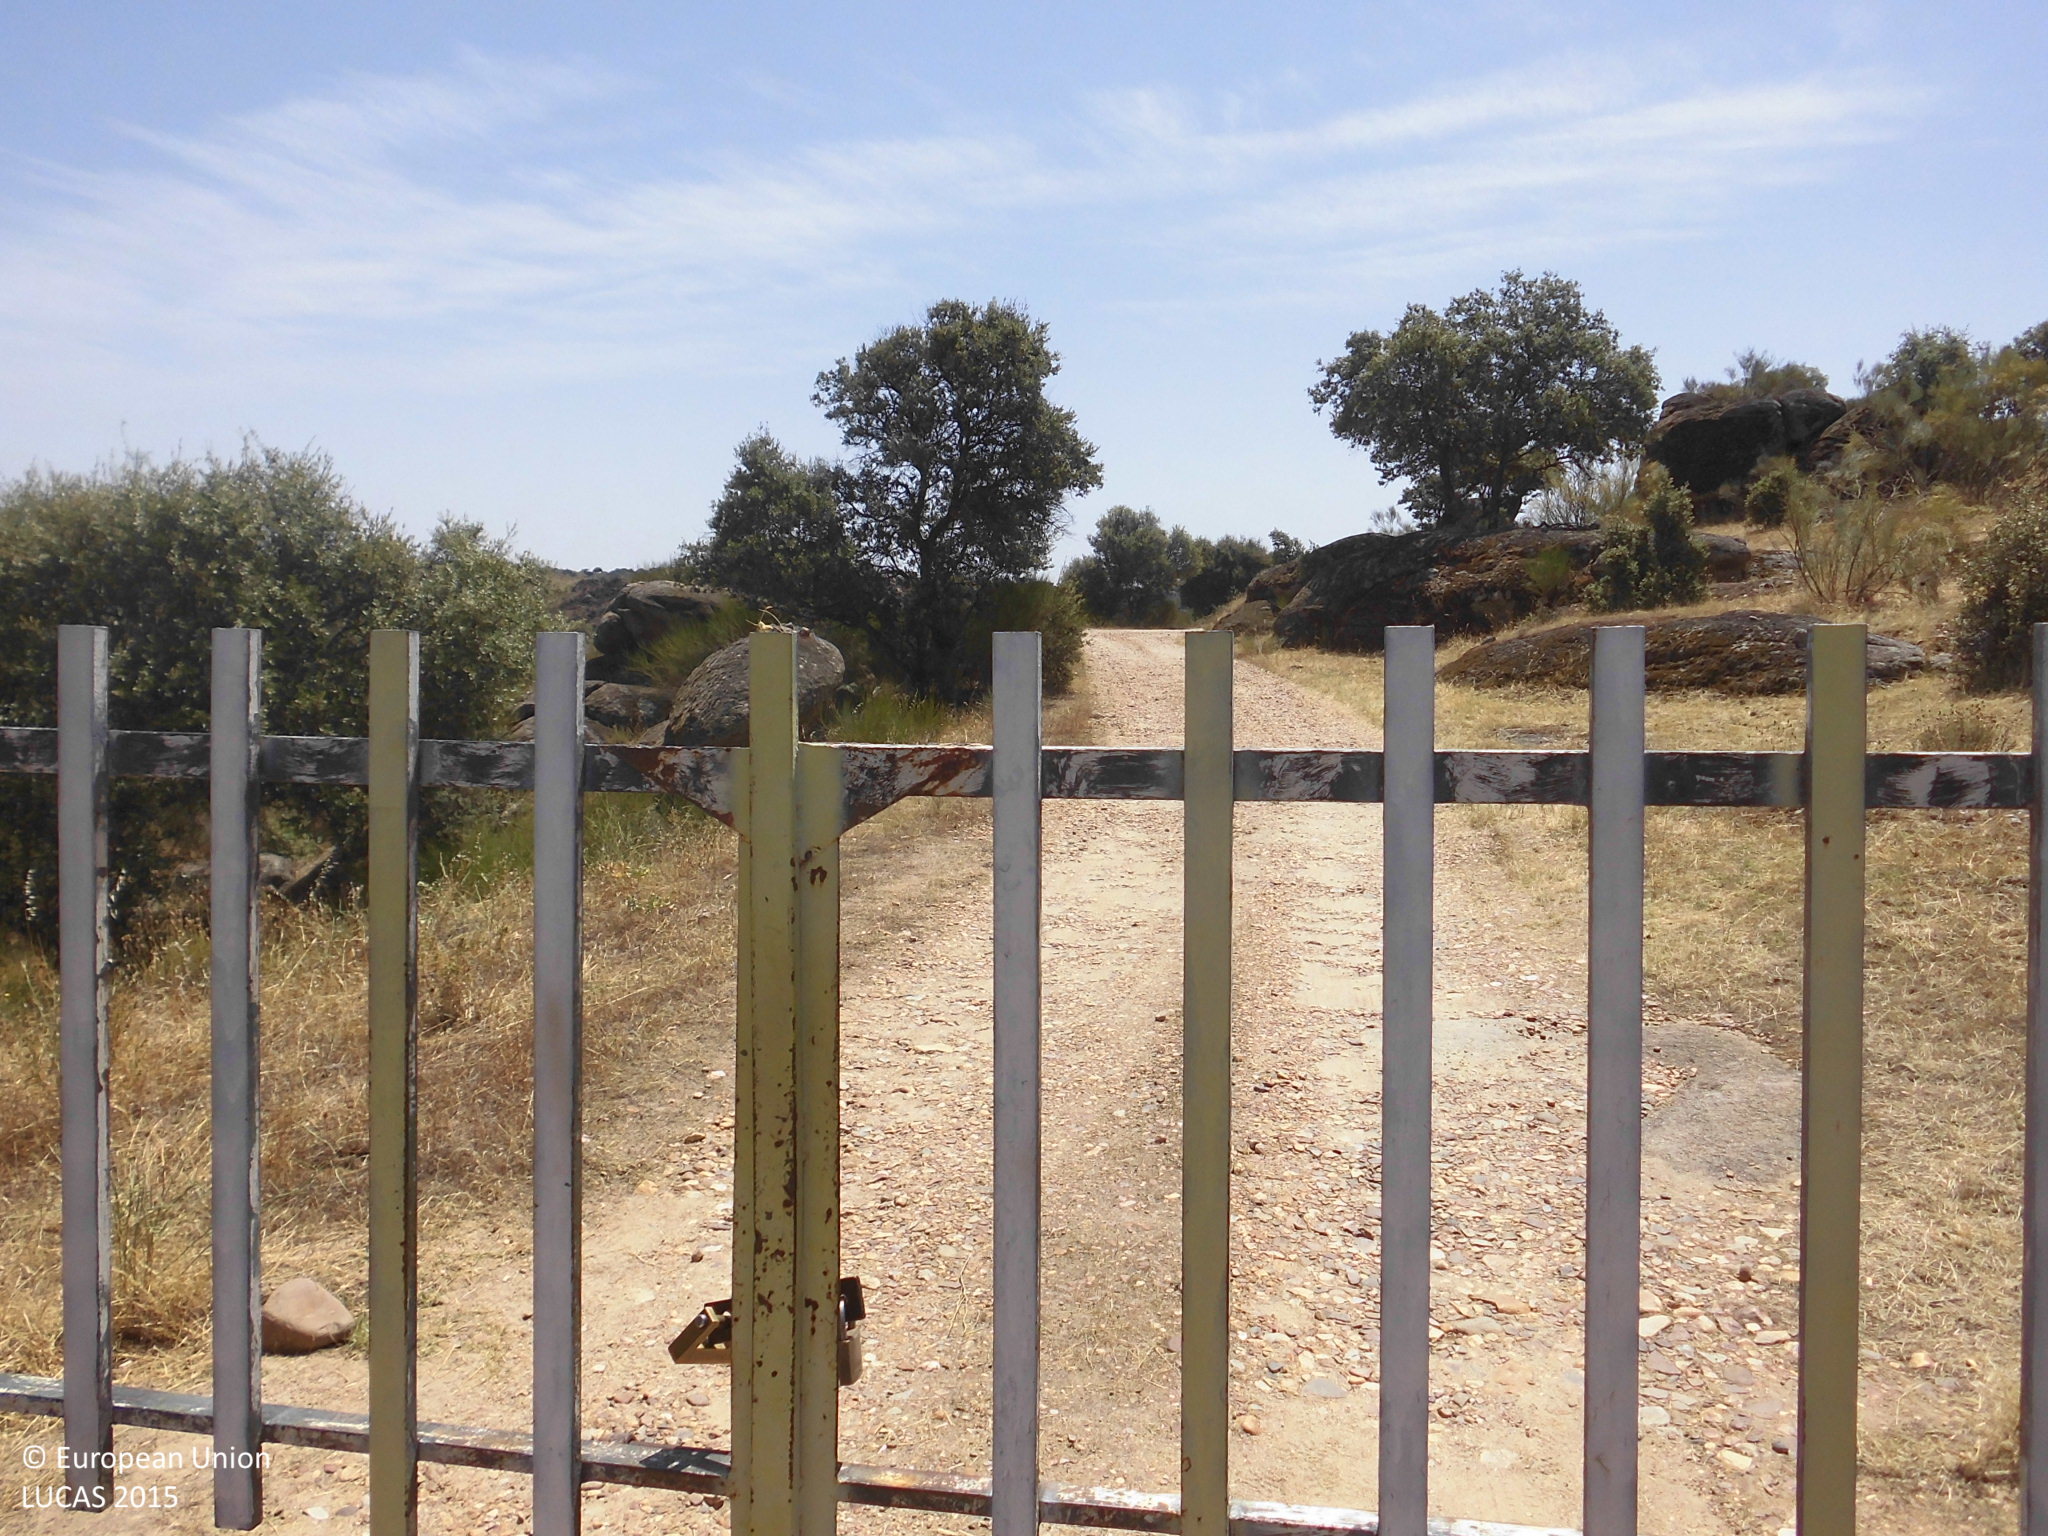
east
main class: Woodland
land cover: Broadleaved woodland
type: broadleaved evergreen forest
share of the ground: 25 - 50 %
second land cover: Grassland without tree/shrub cover
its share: > 75 %
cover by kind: herbaceous plants 60 %, broadleaved forest trees 25 %, shrubs 15 %
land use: Forestry
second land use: Agriculture (excluding fallow land and kitchen gardens)
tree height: > 5 m
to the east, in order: Broadleaved woodland; Grassland without tree/shrub cover; Broadleaved woodland; Tracks; Broadleaved woodland; Grassland with sparse tree/shrub cover
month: July
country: ES
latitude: 39.7559
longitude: -5.4265
